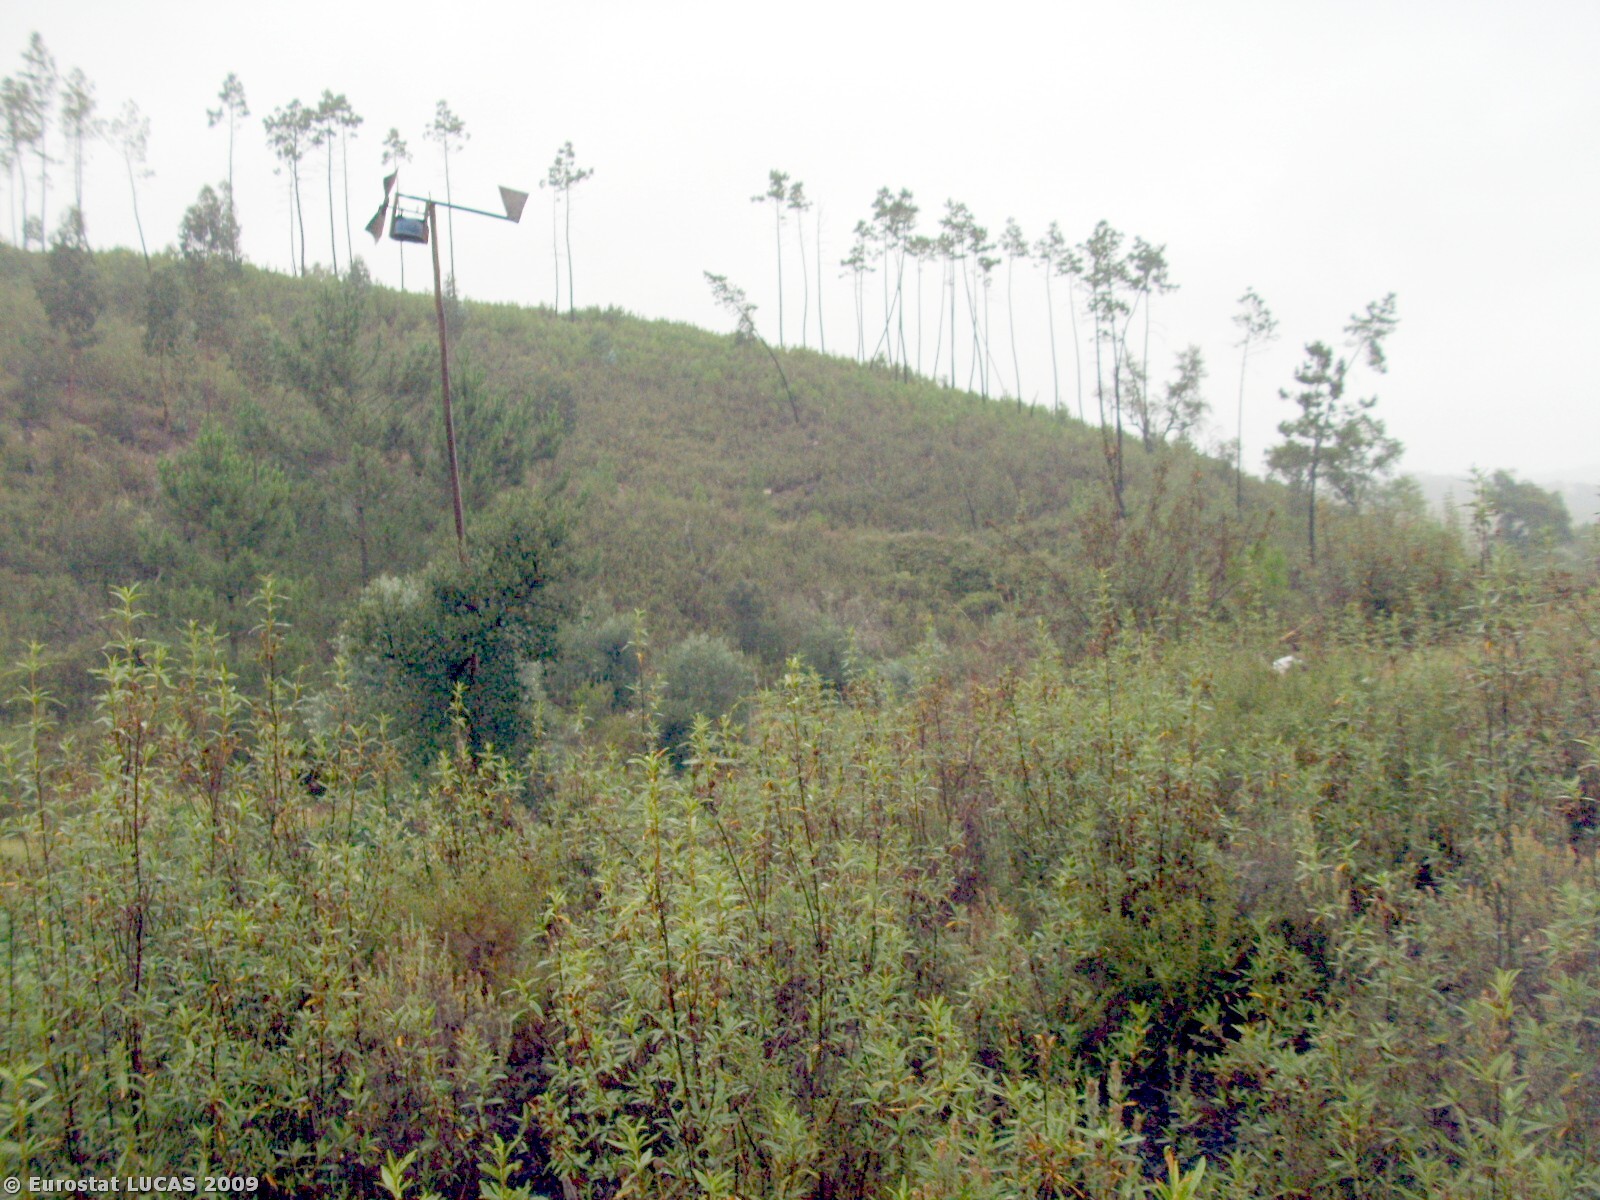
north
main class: Shrubland
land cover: Shrubland with sparse tree cover
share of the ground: > 75 %
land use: Forestry
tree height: > 5 m
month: July
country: PT
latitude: 39.6812
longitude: -8.0781
